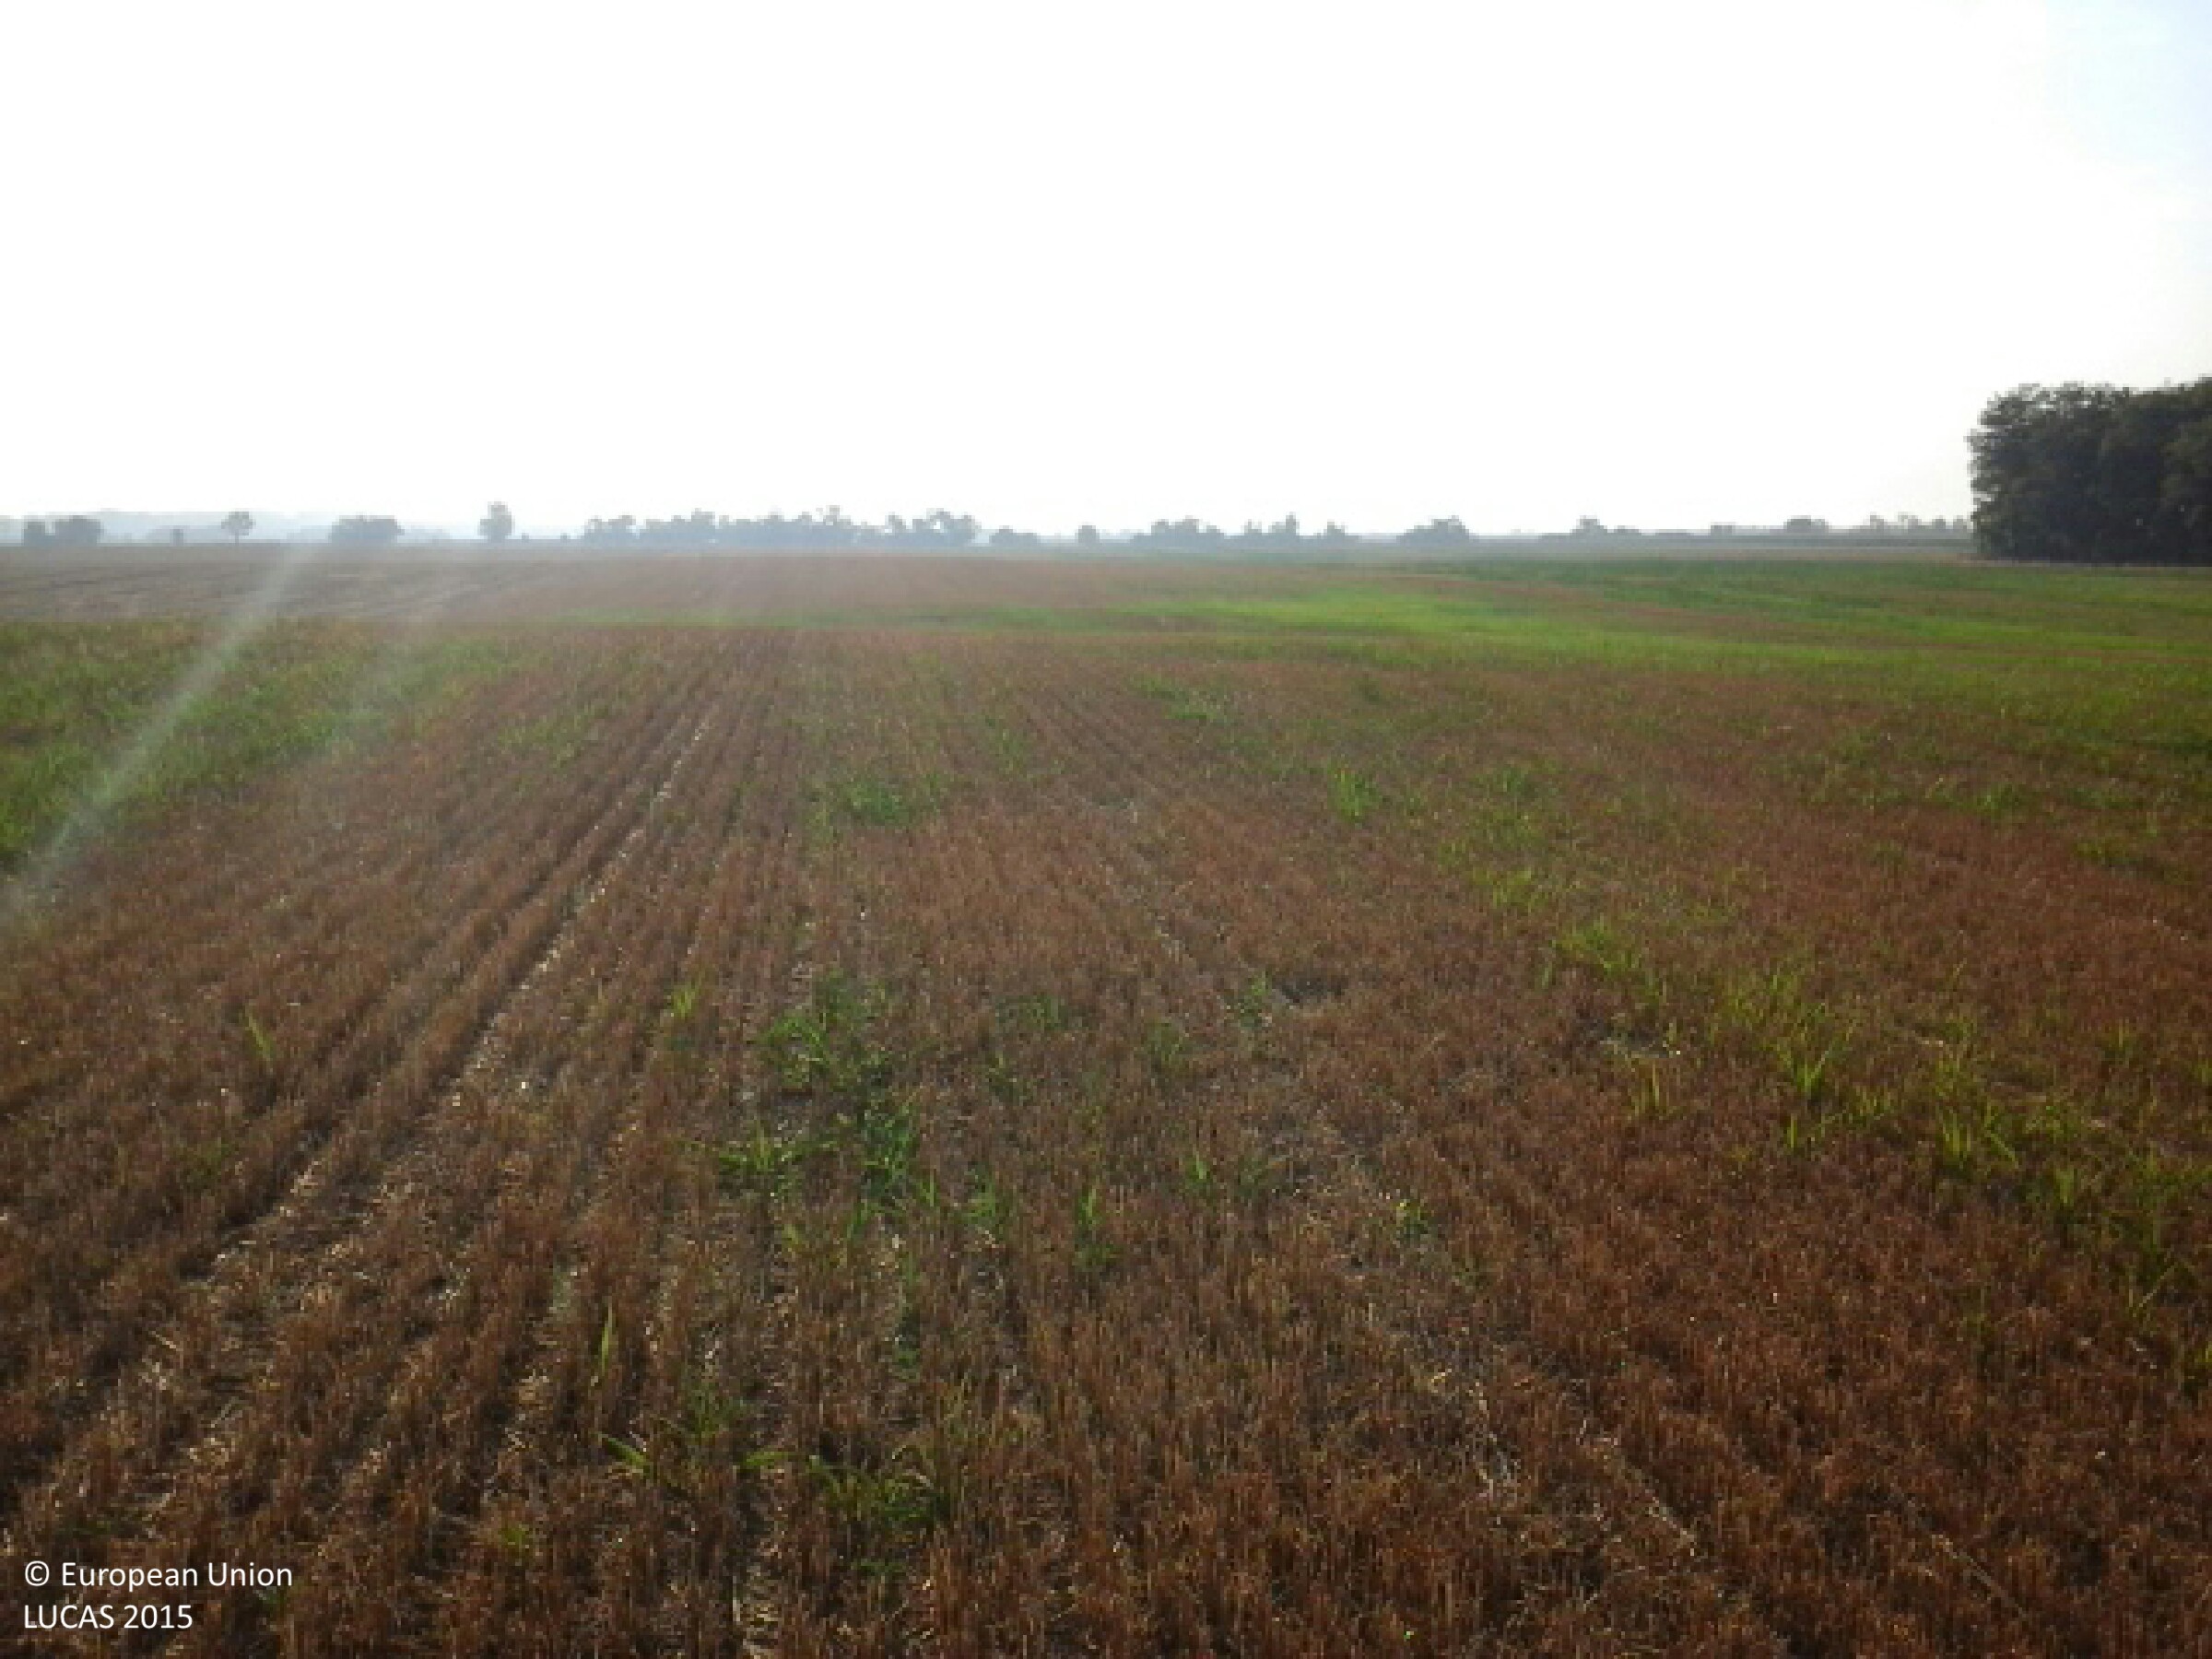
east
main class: Cropland
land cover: Triticale
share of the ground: 10 - 25 %
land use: Agriculture (excluding fallow land and kitchen gardens)
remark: Harvested field
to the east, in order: Triticale
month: August
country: HU
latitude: 47.7197
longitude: 17.9429
